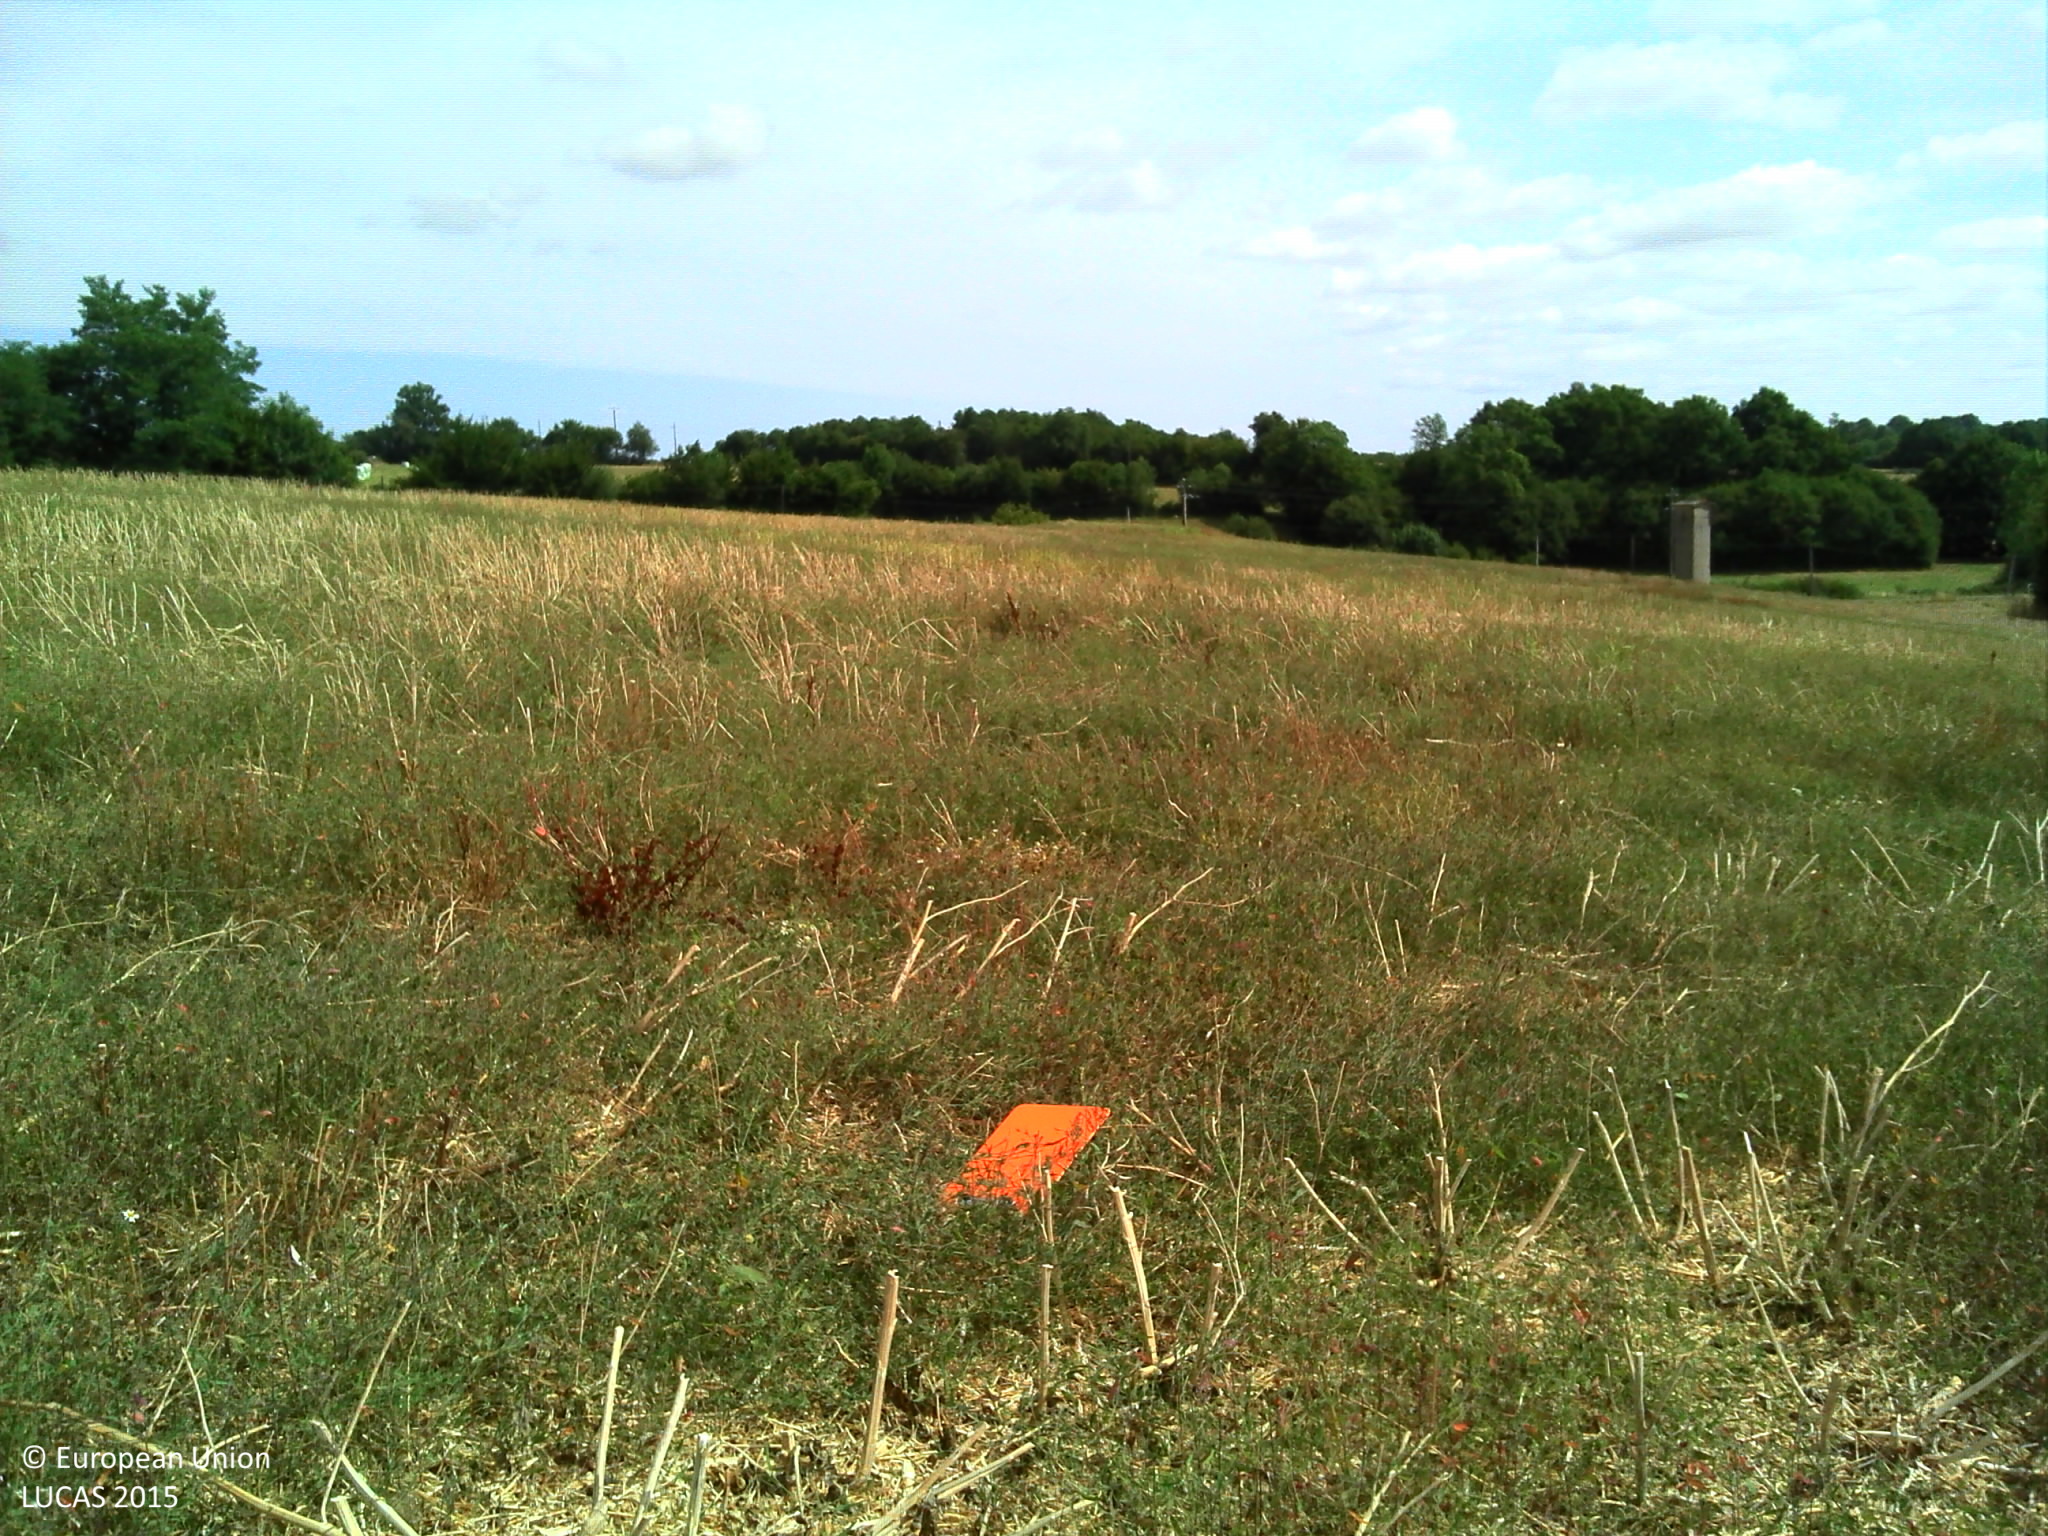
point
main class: Cropland
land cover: Rape and turnip rape
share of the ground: 25 - 50 %
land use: Agriculture (excluding fallow land and kitchen gardens)
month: July
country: FR
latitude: 47.8649
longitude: 0.6881
